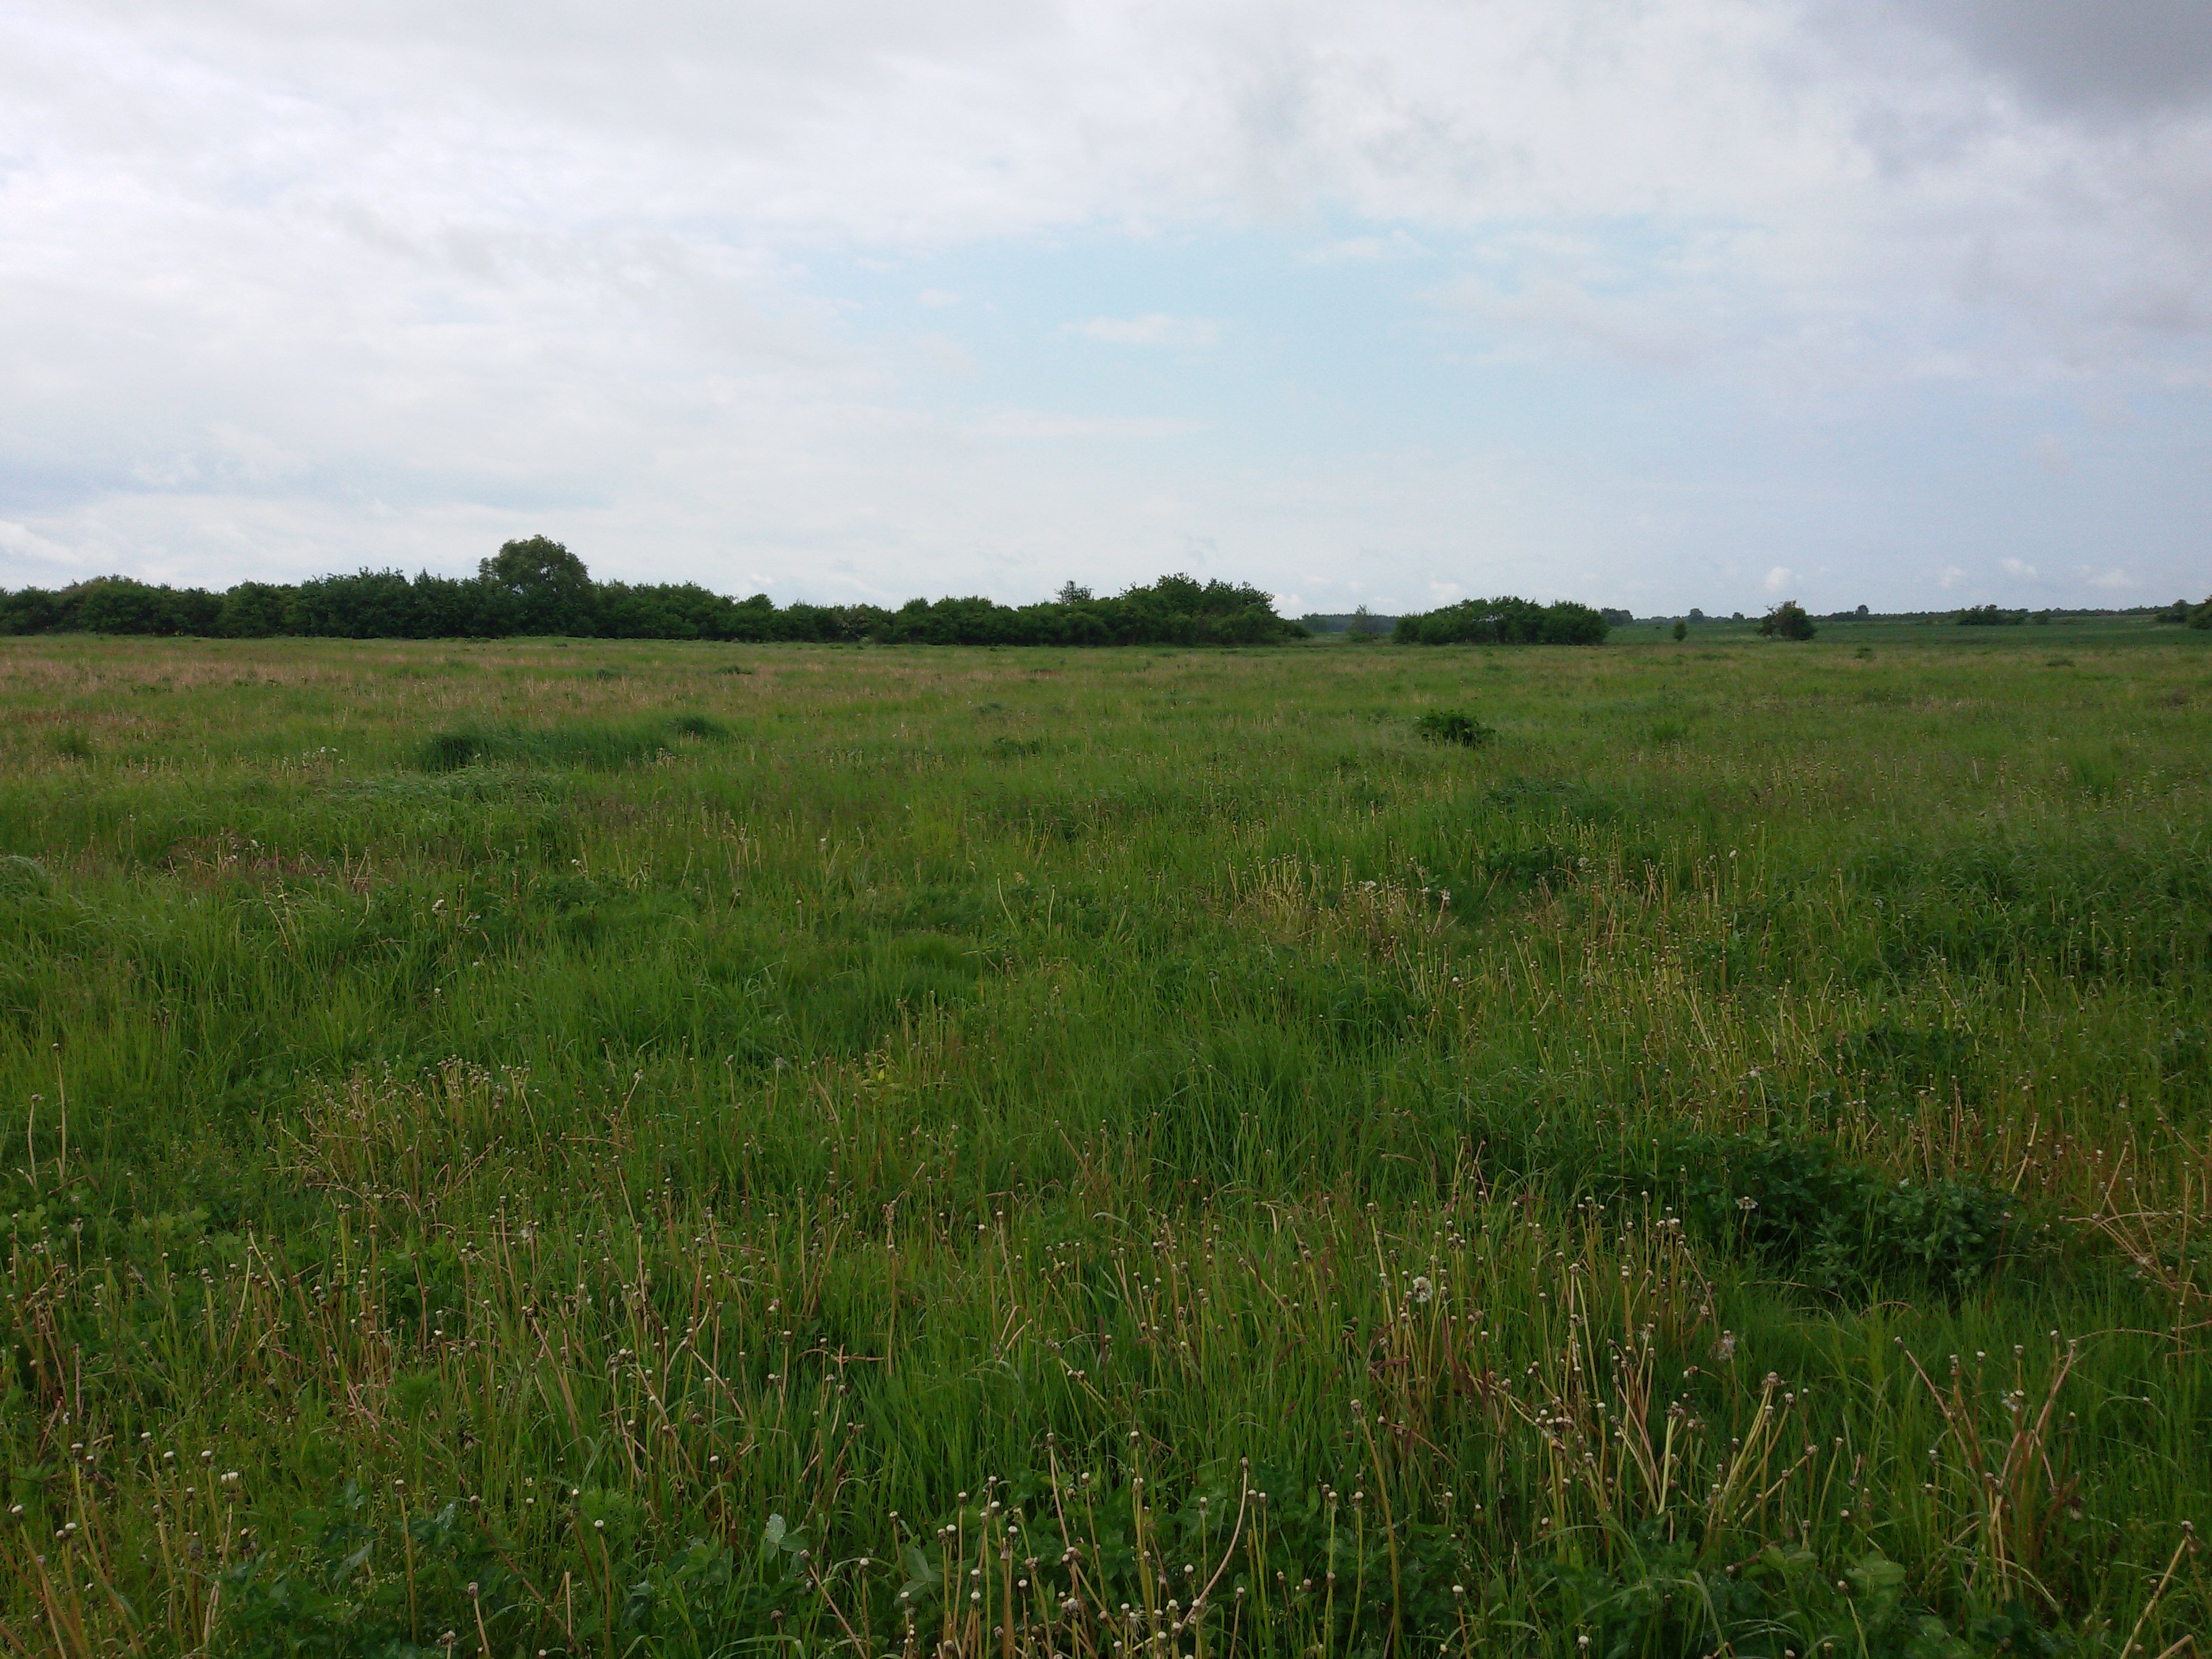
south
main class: Grassland
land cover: Grassland without tree/shrub cover
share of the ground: > 75 %
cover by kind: herbaceous plants 100 %
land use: Agriculture (excluding fallow land and kitchen gardens)
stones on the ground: < 10 %
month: May
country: PL
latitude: 53.2605
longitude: 14.6037
